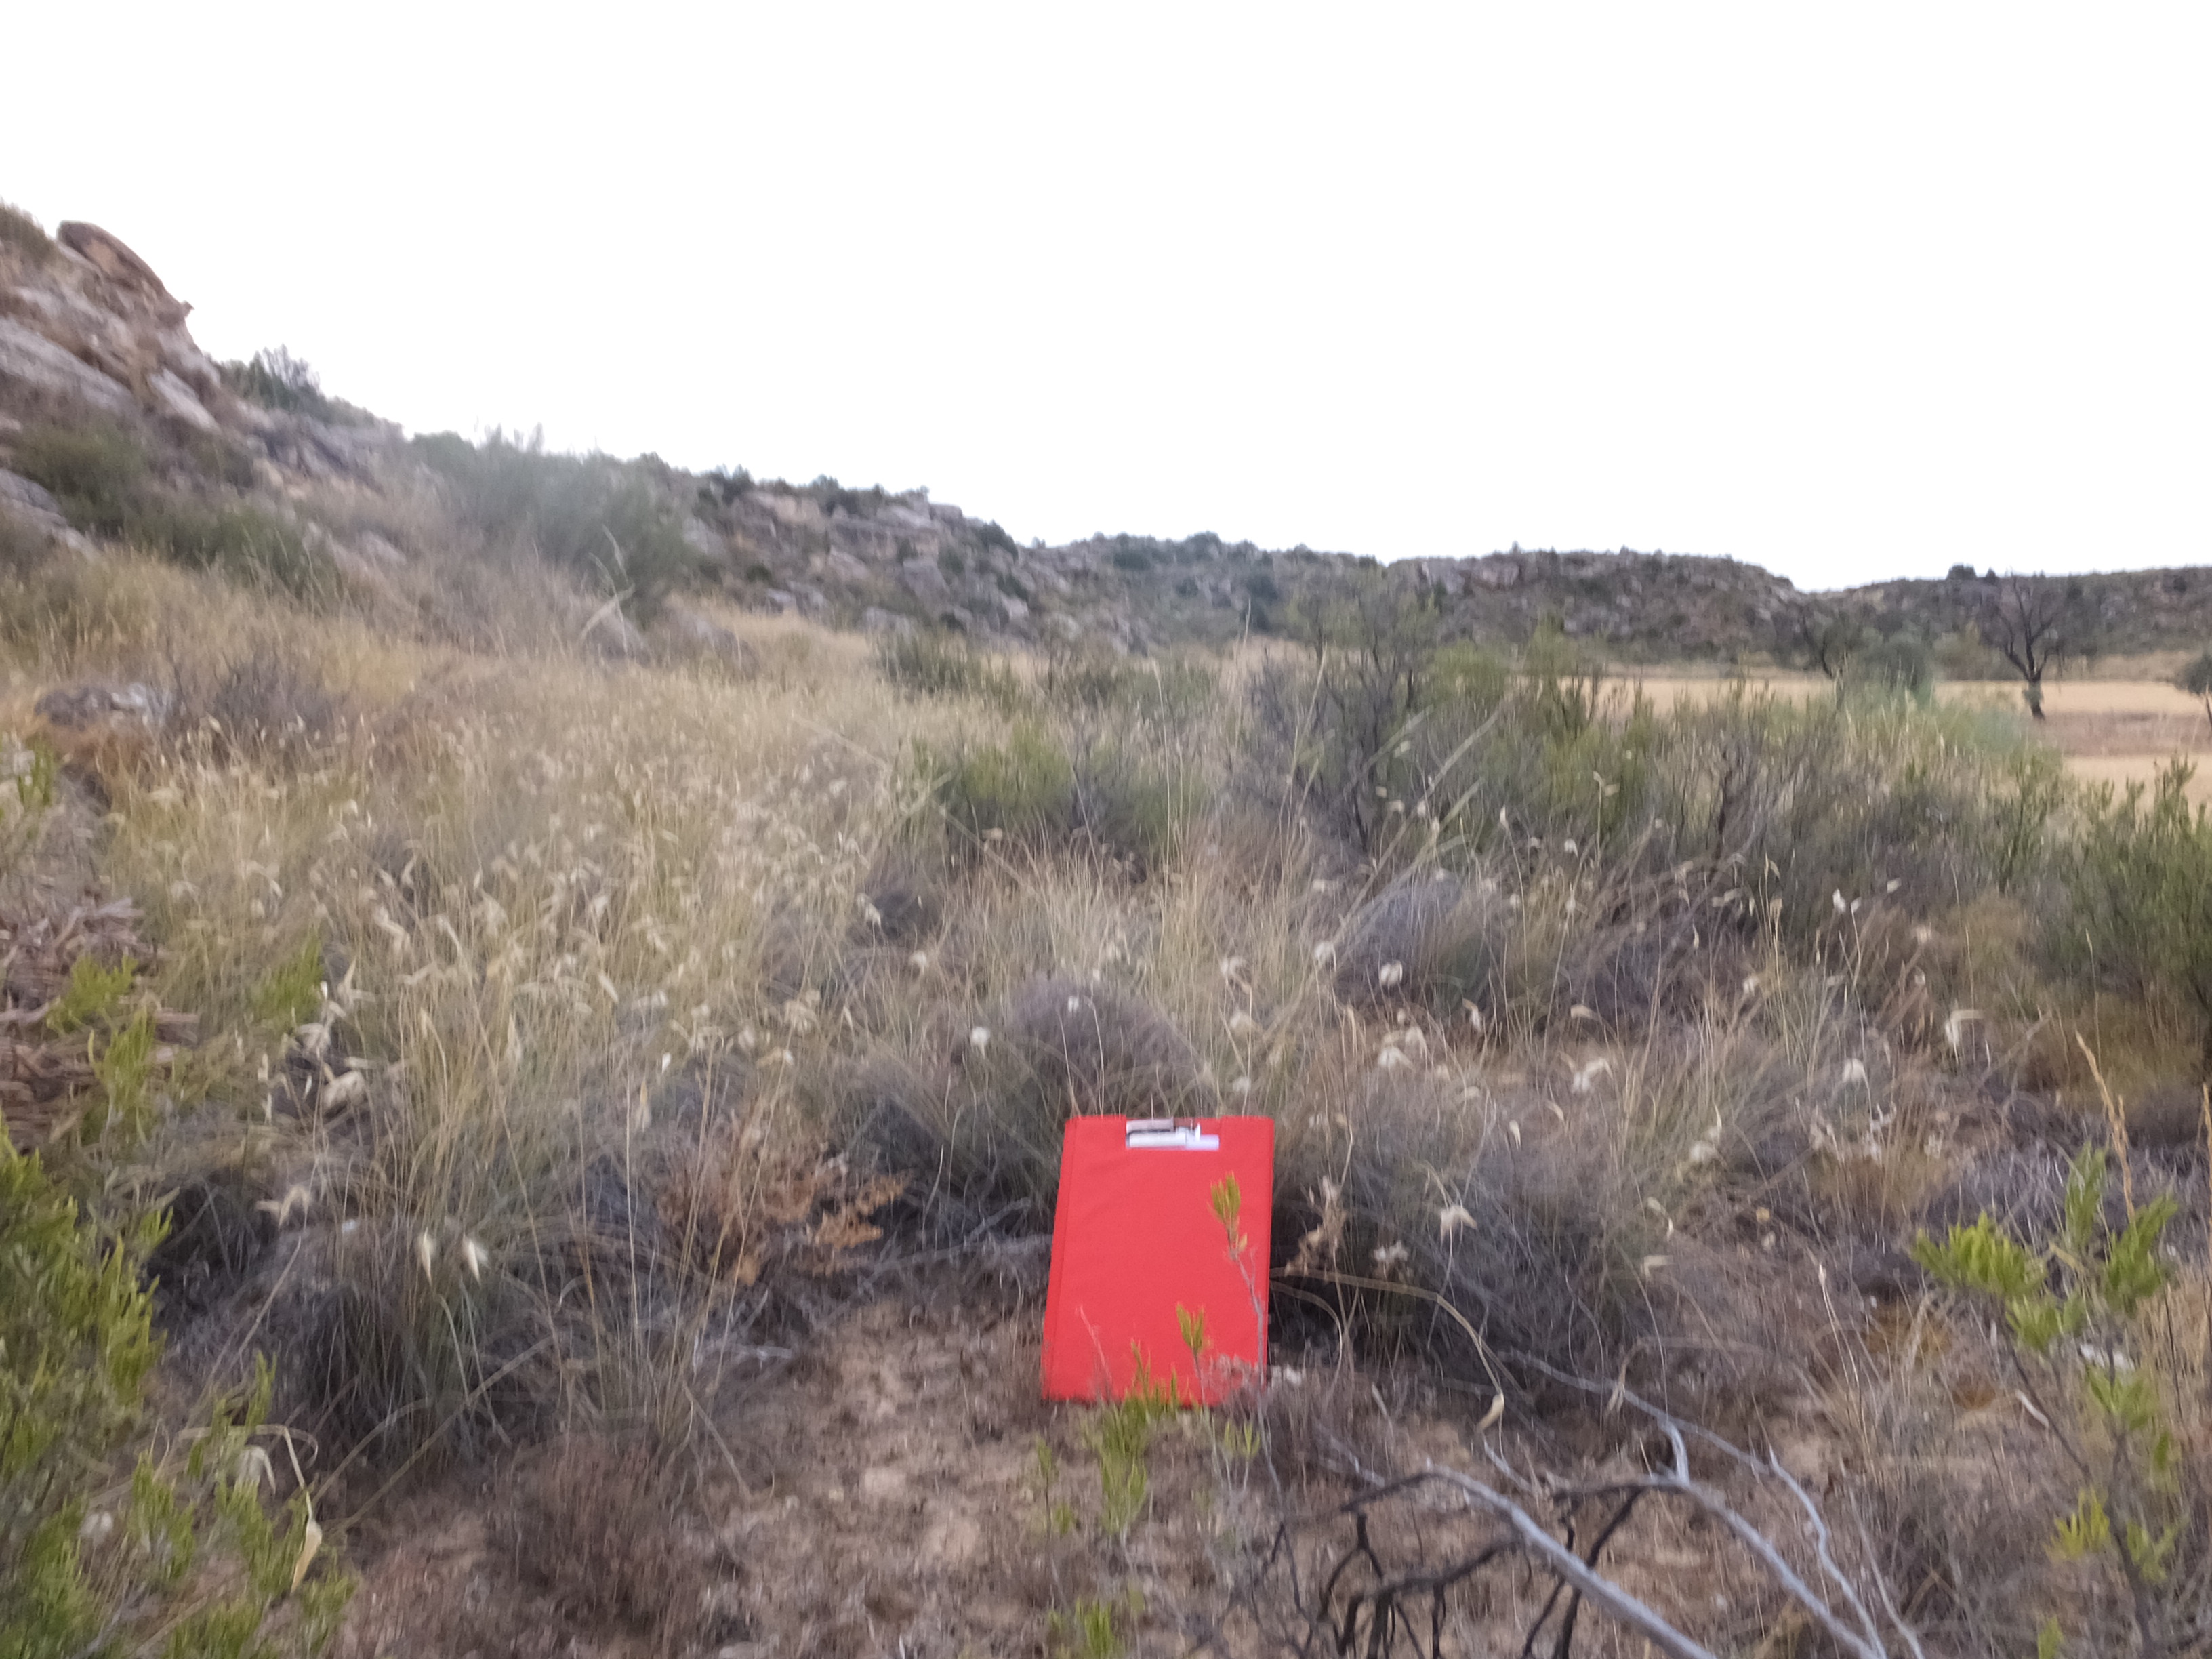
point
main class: Shrubland
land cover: Shrubland without tree cover
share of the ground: > 75 %
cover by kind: shrubs 50 %, herbaceous plants 50 %
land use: Semi-natural and natural areas not in use
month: July
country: ES
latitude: 41.1850
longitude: -0.0863
